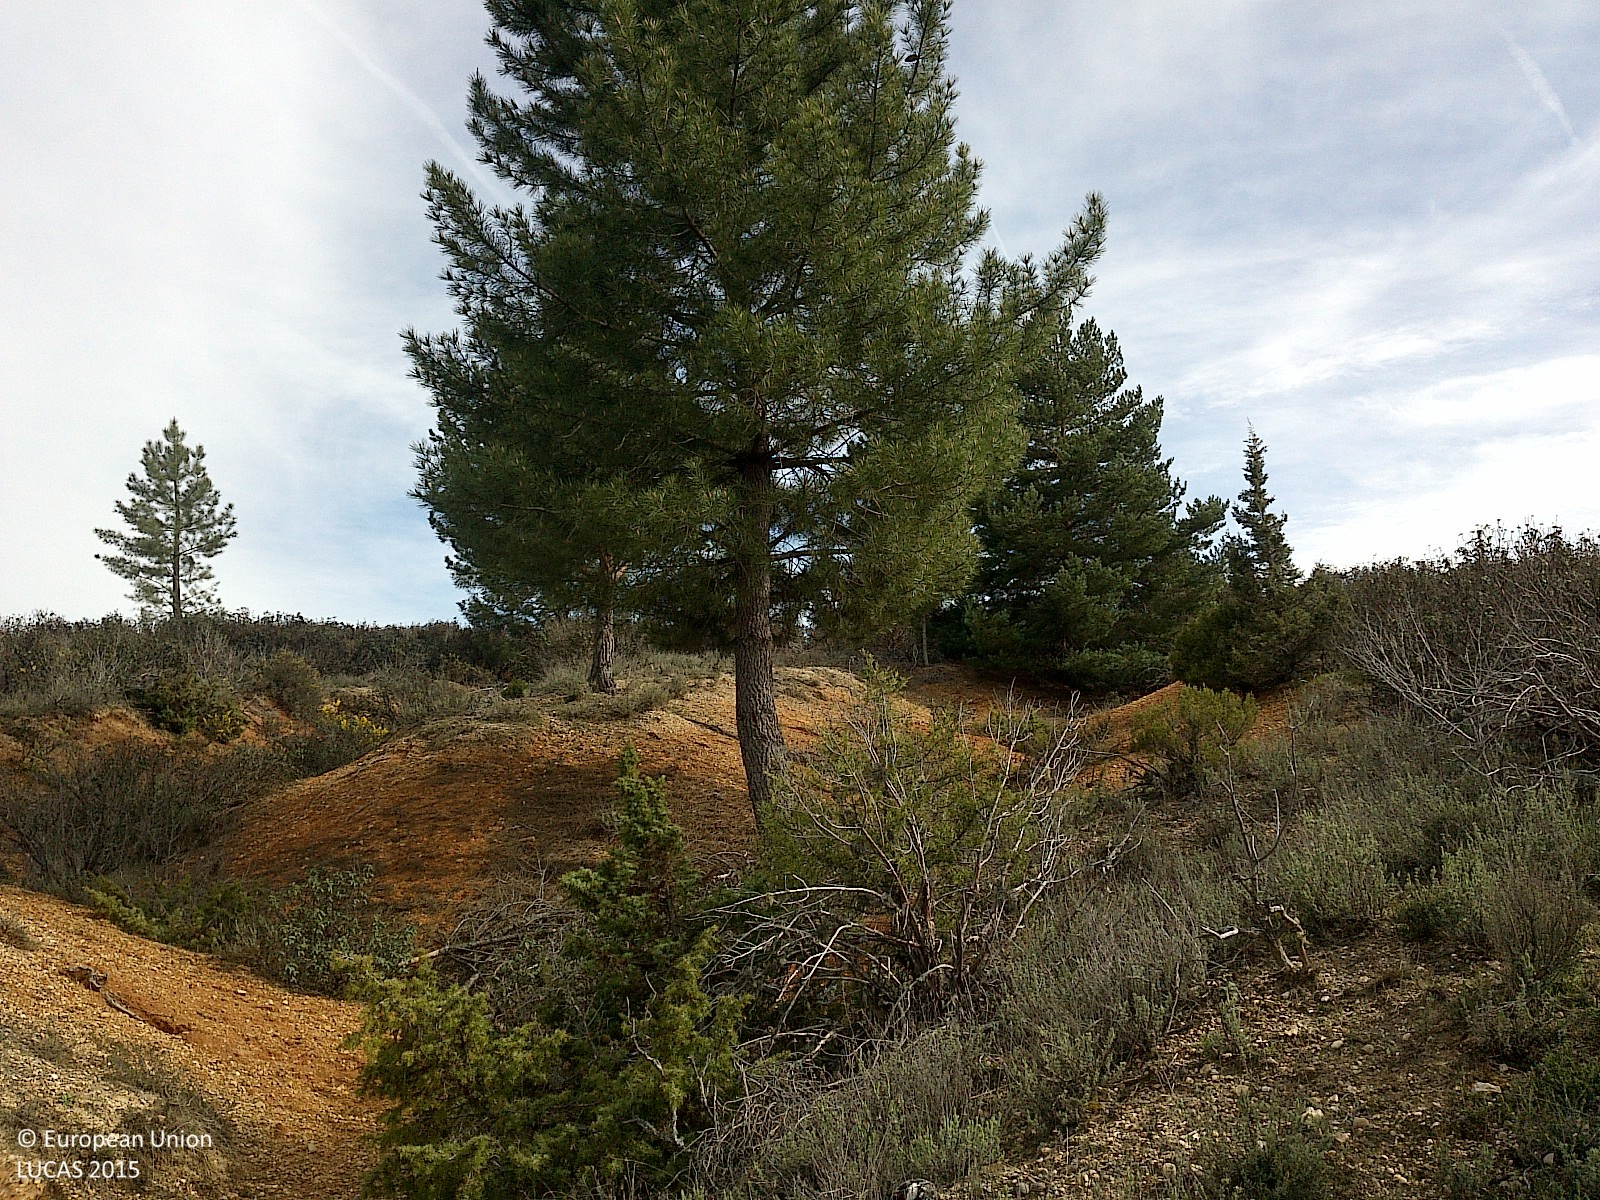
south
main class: Shrubland
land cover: Shrubland with sparse tree cover
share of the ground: 50 - 75 %
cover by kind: shrubs 65 %, herbaceous plants 20 %, unconsolidated bare surface 10 %, coniferous forest trees 5 %
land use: Semi-natural and natural areas not in use
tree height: > 5 m
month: April
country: ES
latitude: 41.7276
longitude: -3.0886
